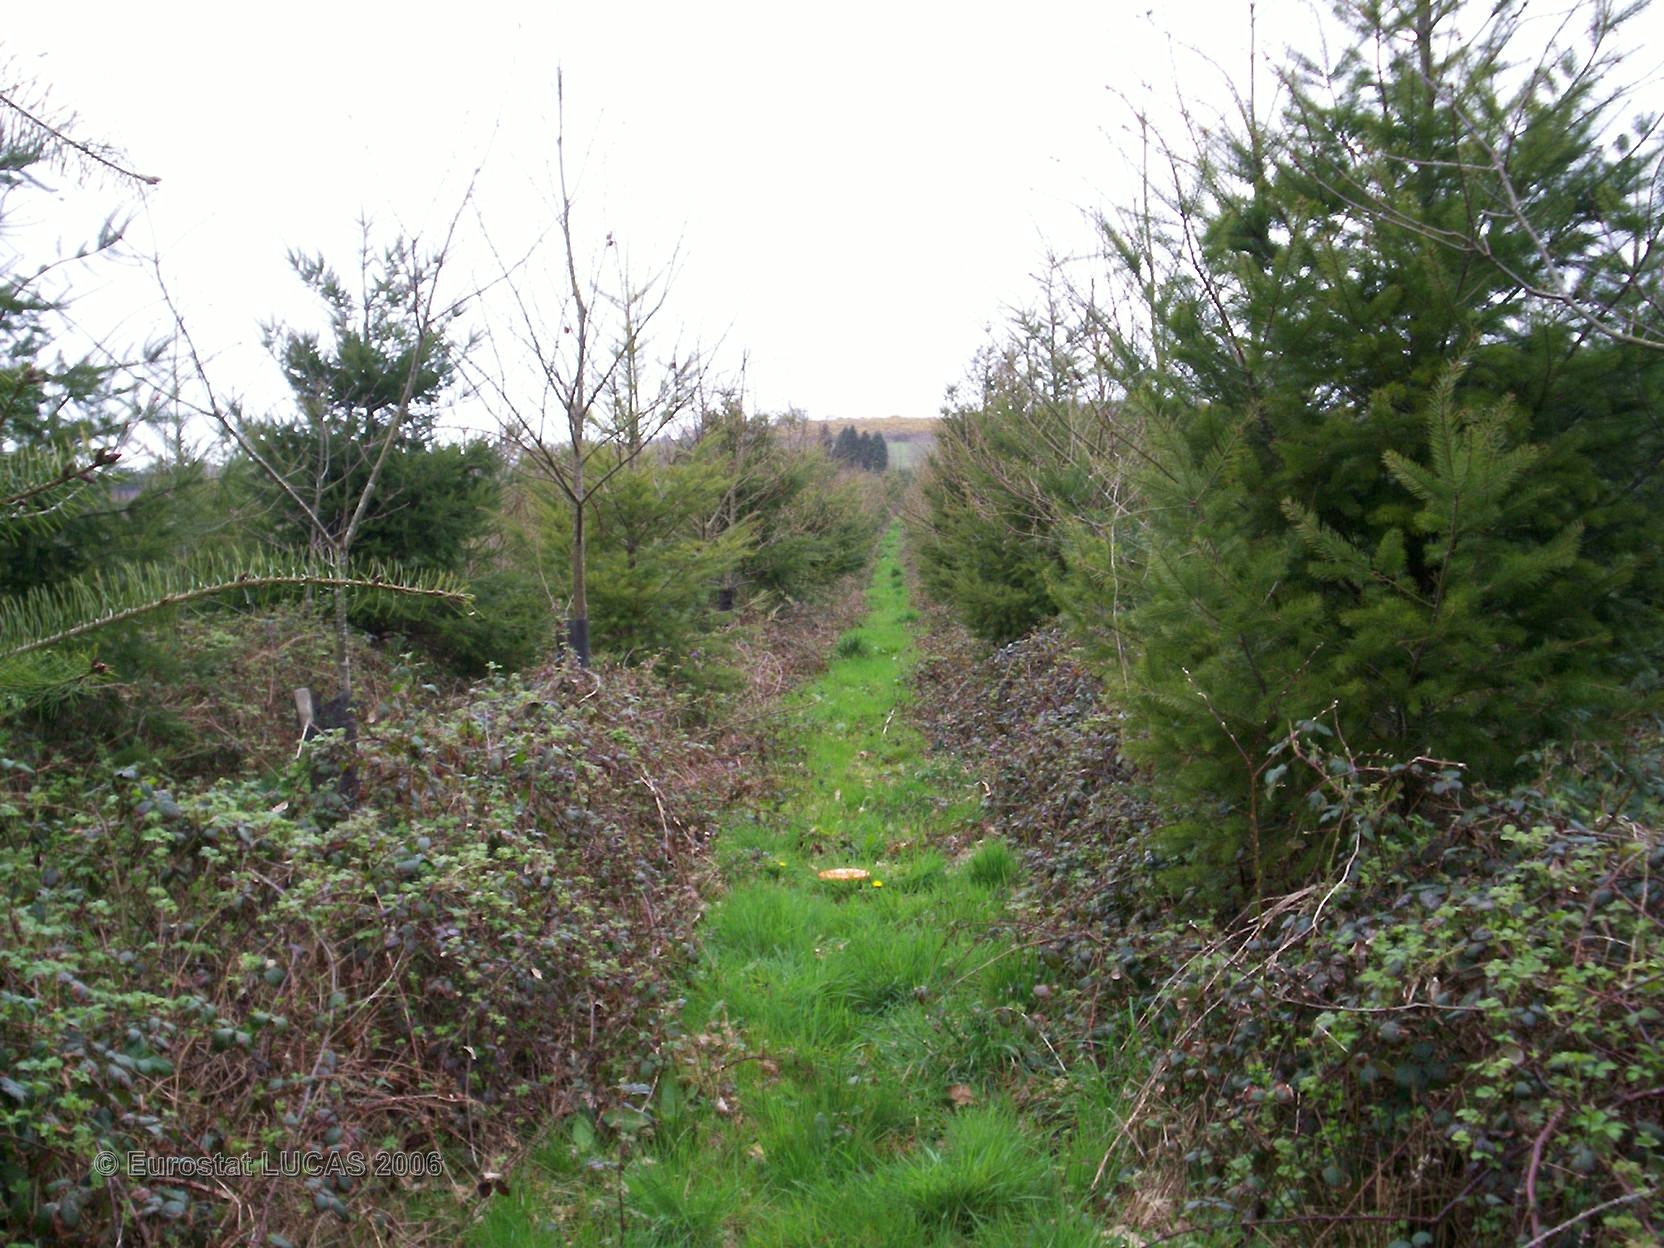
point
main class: Woodland
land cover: Coniferous forest
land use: Forestry
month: April
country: FR
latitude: 47.9961
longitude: -3.6007
